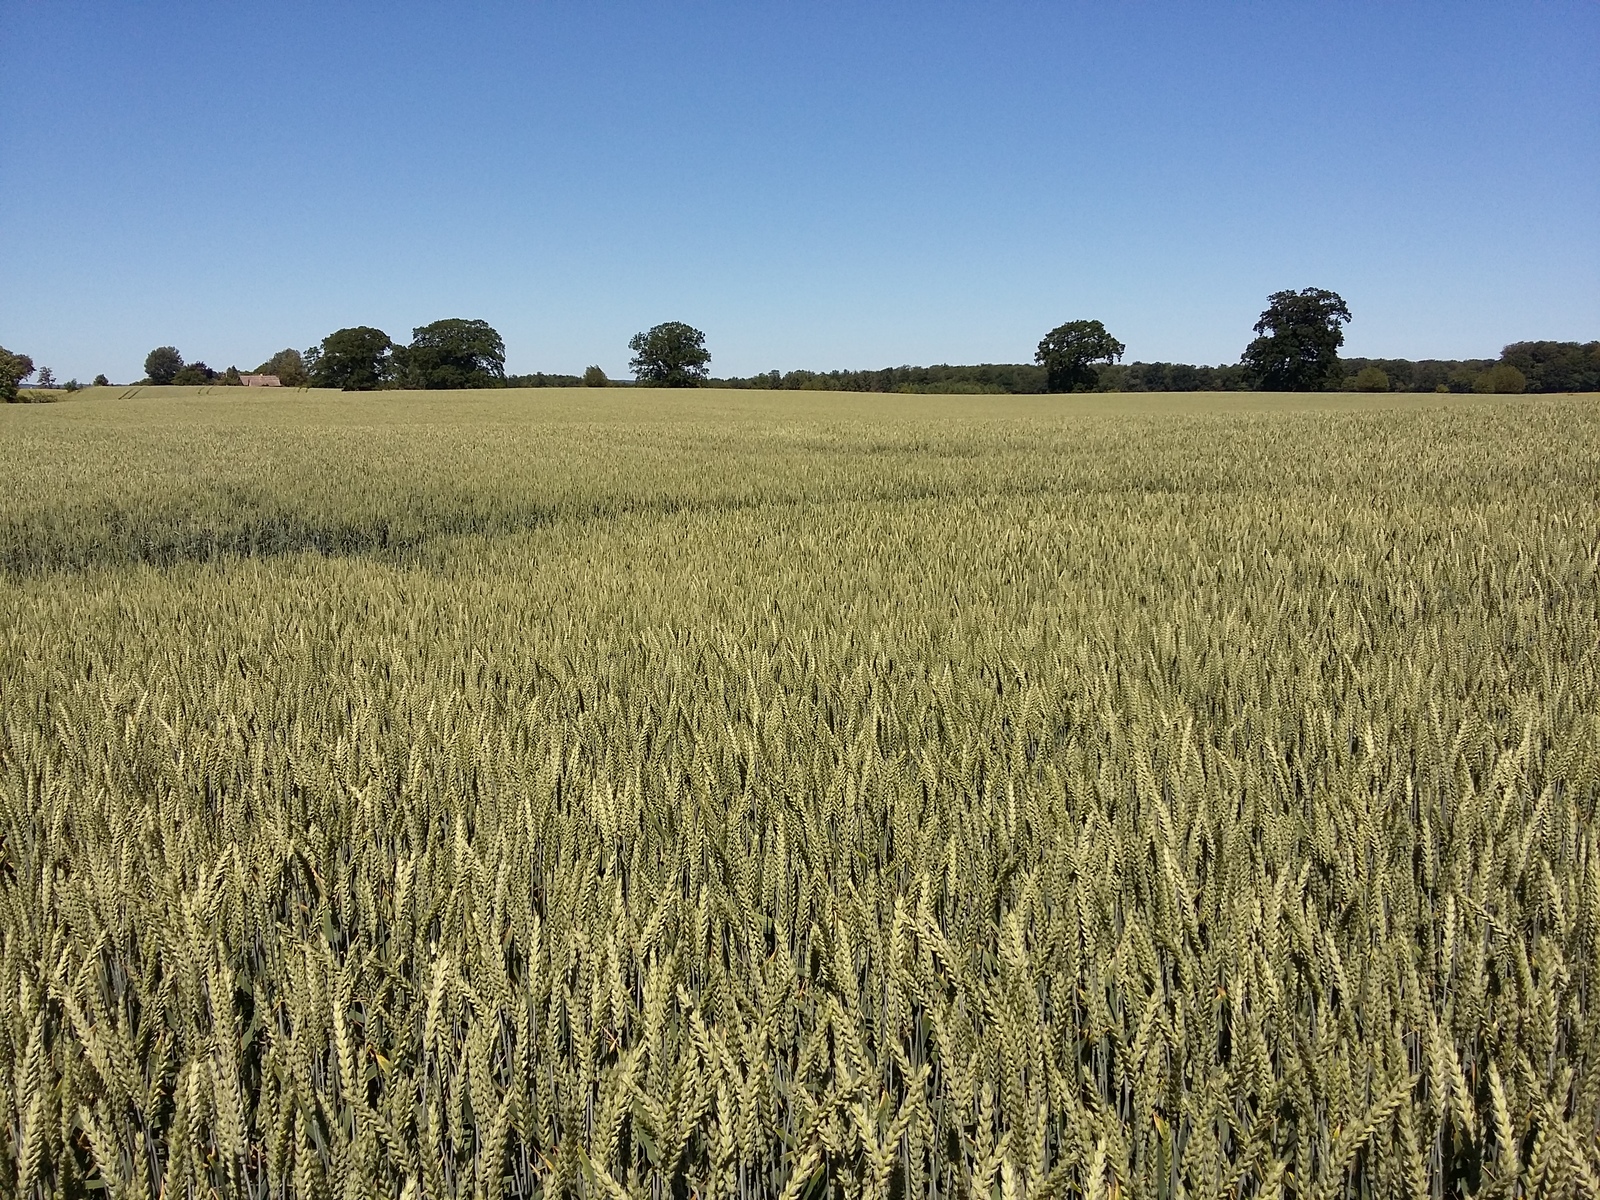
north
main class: Cropland
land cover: Common wheat
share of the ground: > 75 %
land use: Agriculture (excluding fallow land and kitchen gardens)
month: July
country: DK
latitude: 55.1290
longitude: 12.0217
